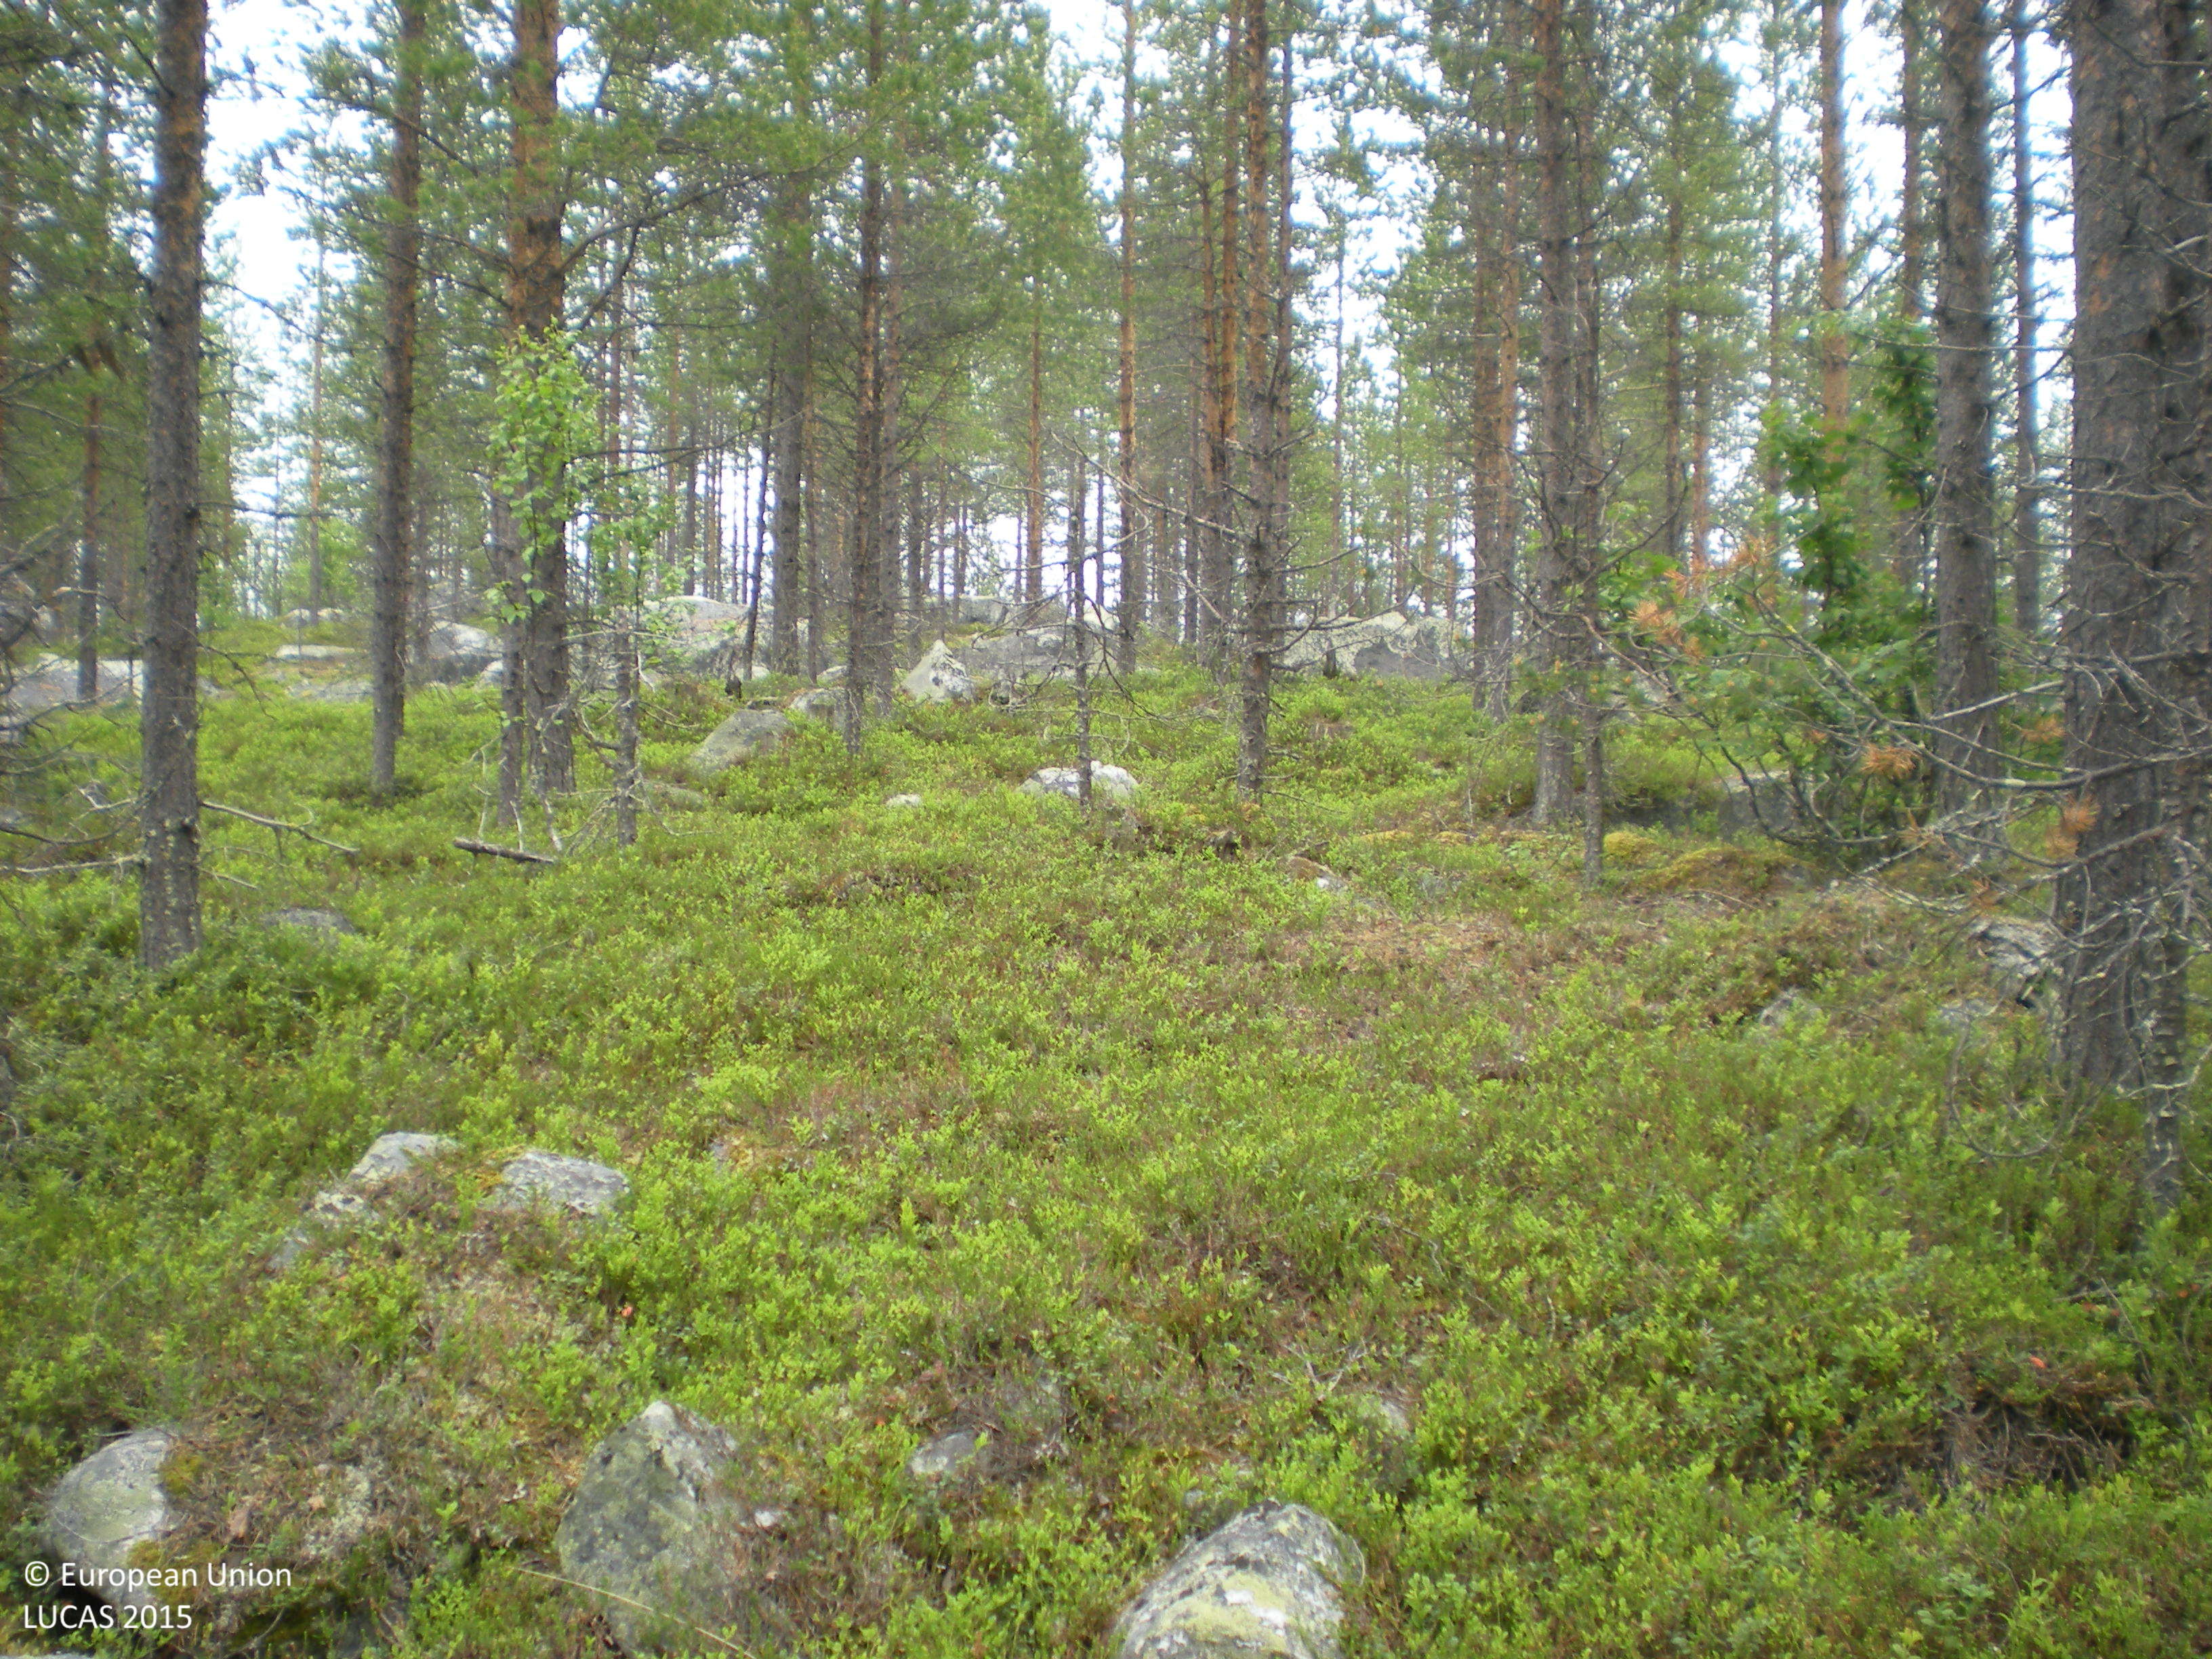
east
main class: Woodland
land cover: Pine dominated coniferous woodland
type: boreal forest
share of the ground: 50 - 75 %
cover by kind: coniferous forest trees 55 %, shrubs 30 %, consolidated bare surface 10 %, lichens and mosses 5 %
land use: Forestry
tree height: > 5 m
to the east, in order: Pine dominated coniferous woodland; Inland fresh water bodies; Pine dominated coniferous woodland; Rocks and stones
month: July
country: SE
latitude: 65.5109
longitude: 17.0733
